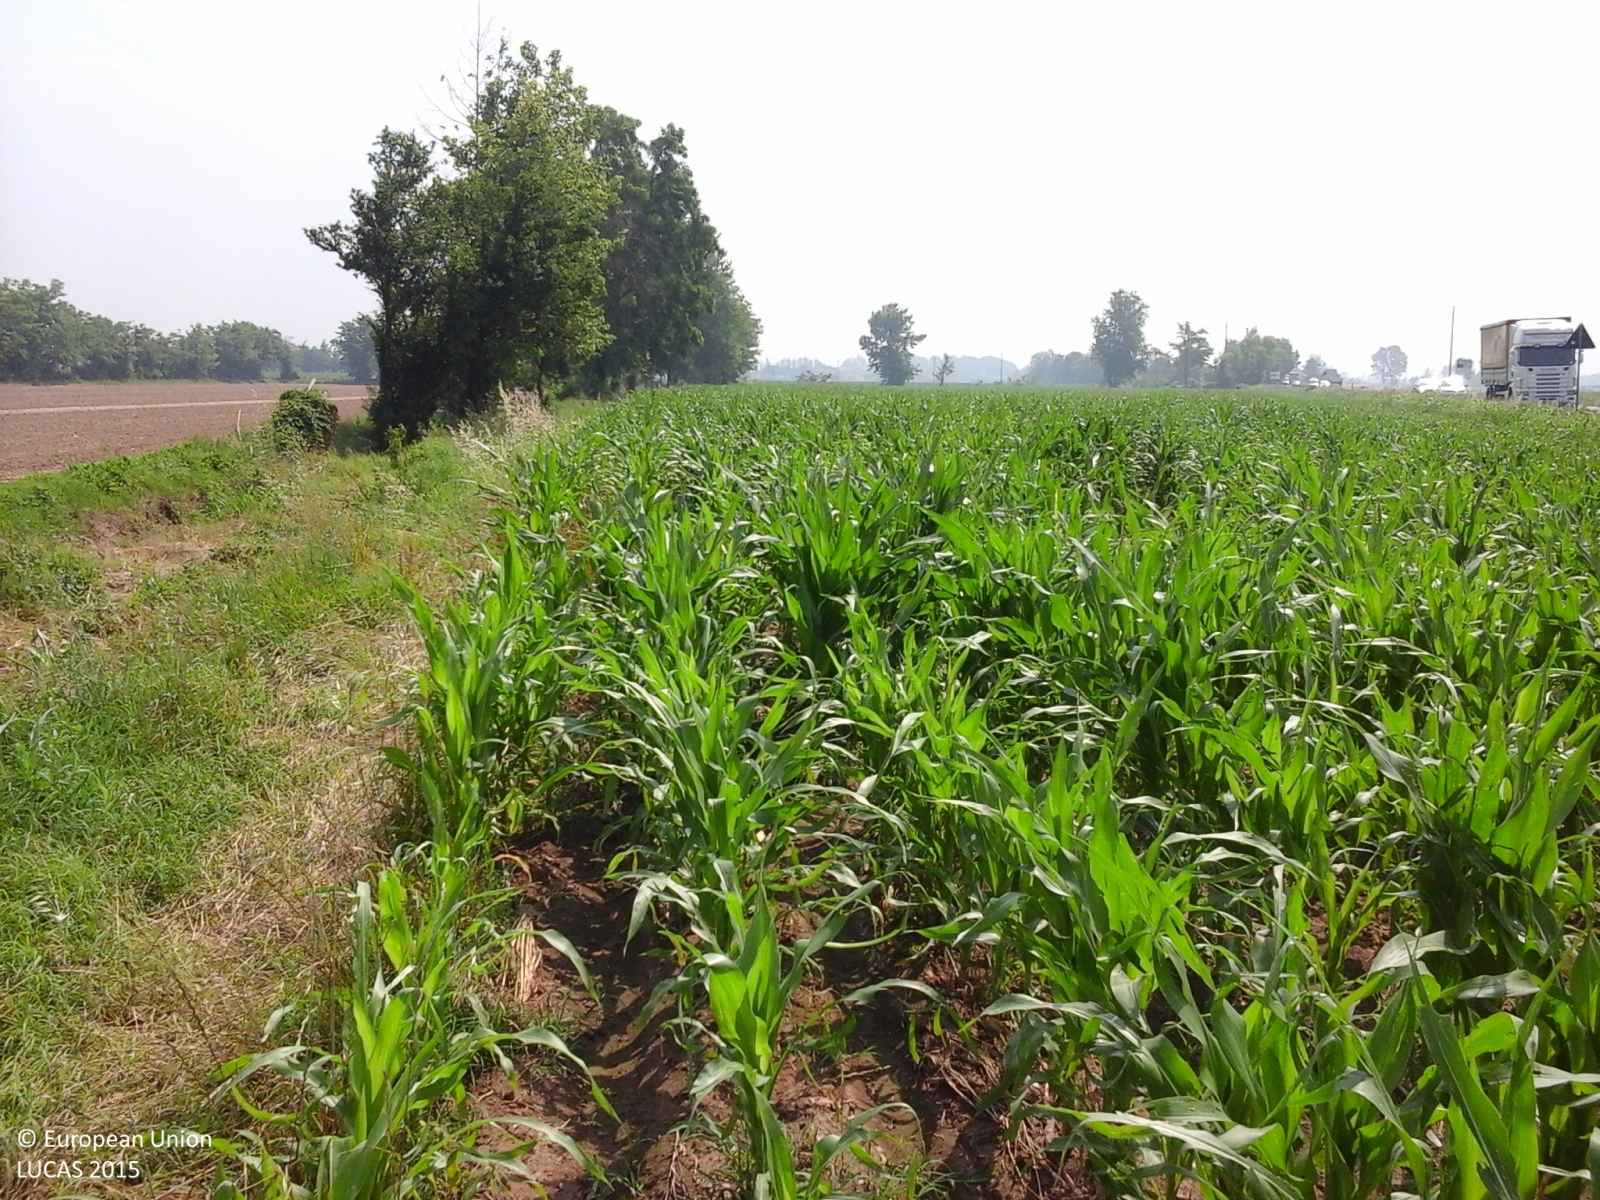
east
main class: Cropland
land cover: Maize
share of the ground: > 75 %
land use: Agriculture (excluding fallow land and kitchen gardens)
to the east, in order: Maize
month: June
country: IT
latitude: 45.3782
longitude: 10.0637
